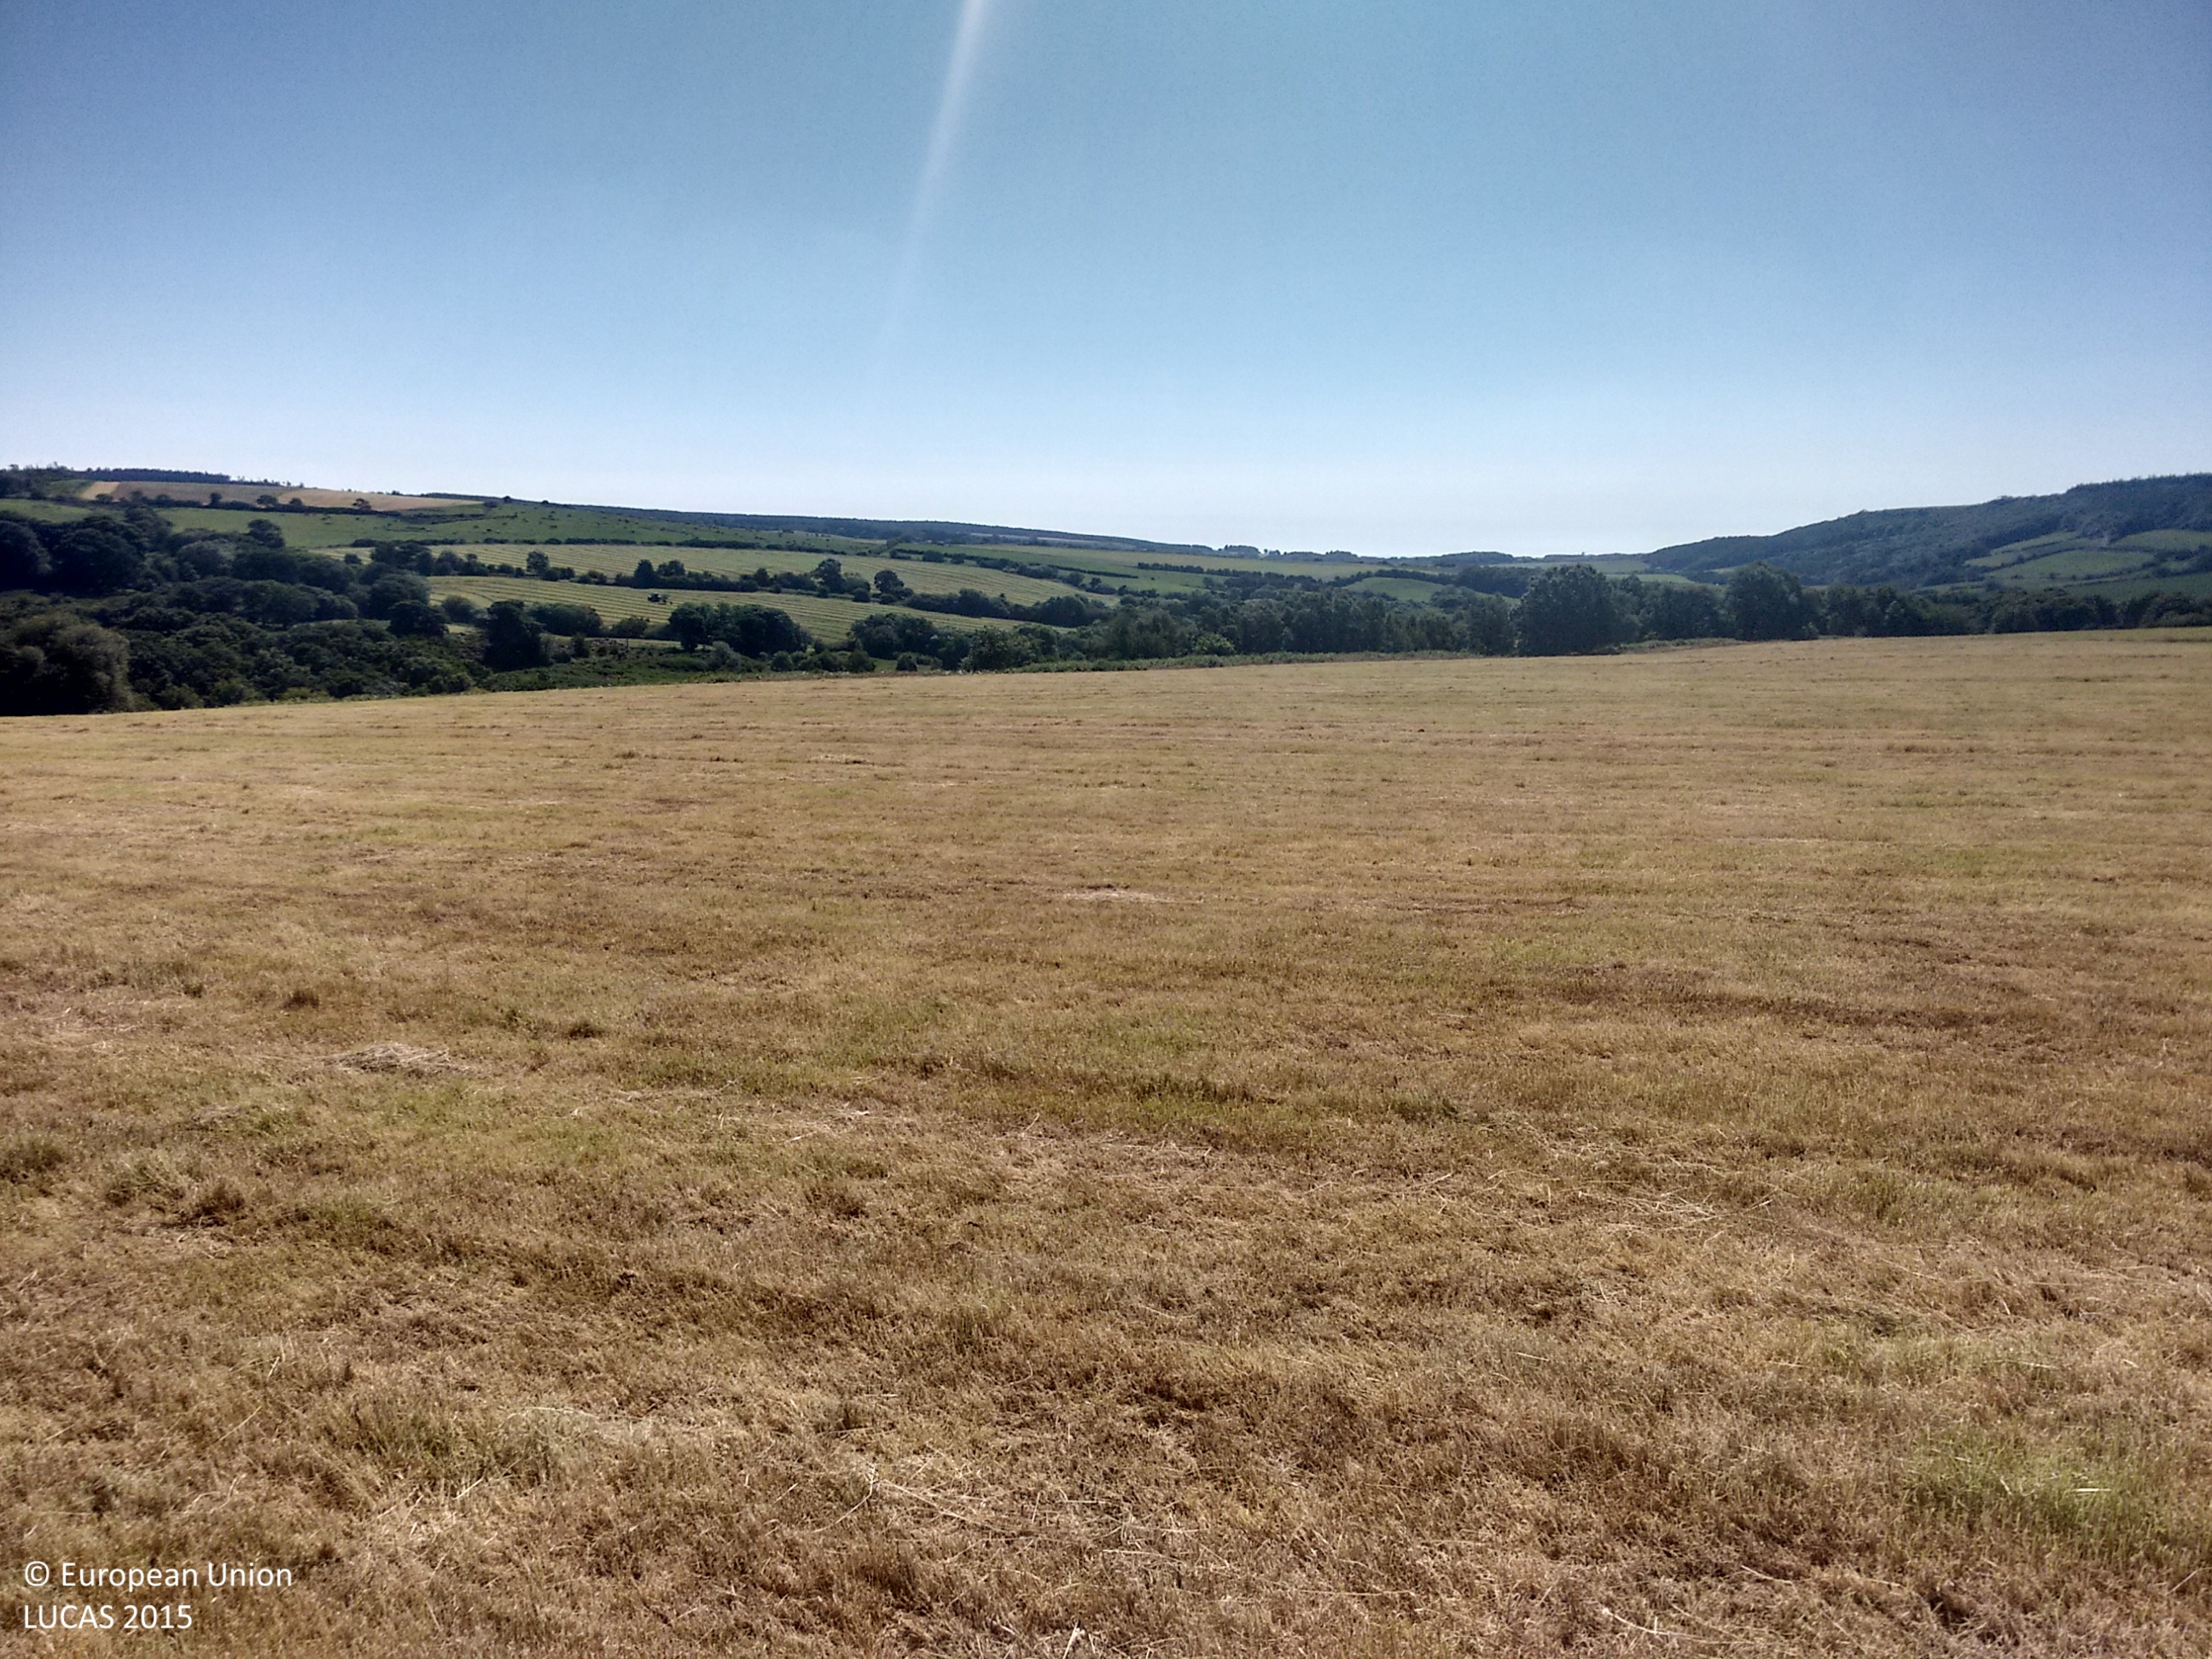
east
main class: Grassland
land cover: Grassland without tree/shrub cover
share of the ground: > 75 %
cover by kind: herbaceous plants 100 %
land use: Agriculture (excluding fallow land and kitchen gardens)
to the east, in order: Grassland without tree/shrub cover; Electric lines; Grassland without tree/shrub cover; Fences; Grassland with sparse tree/shrub cover; Broadleaved woodland; Electric lines; Broadleaved woodland; Rivers and streams; Broadleaved woodland
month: July
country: GB
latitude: 54.3549
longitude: -0.5457
